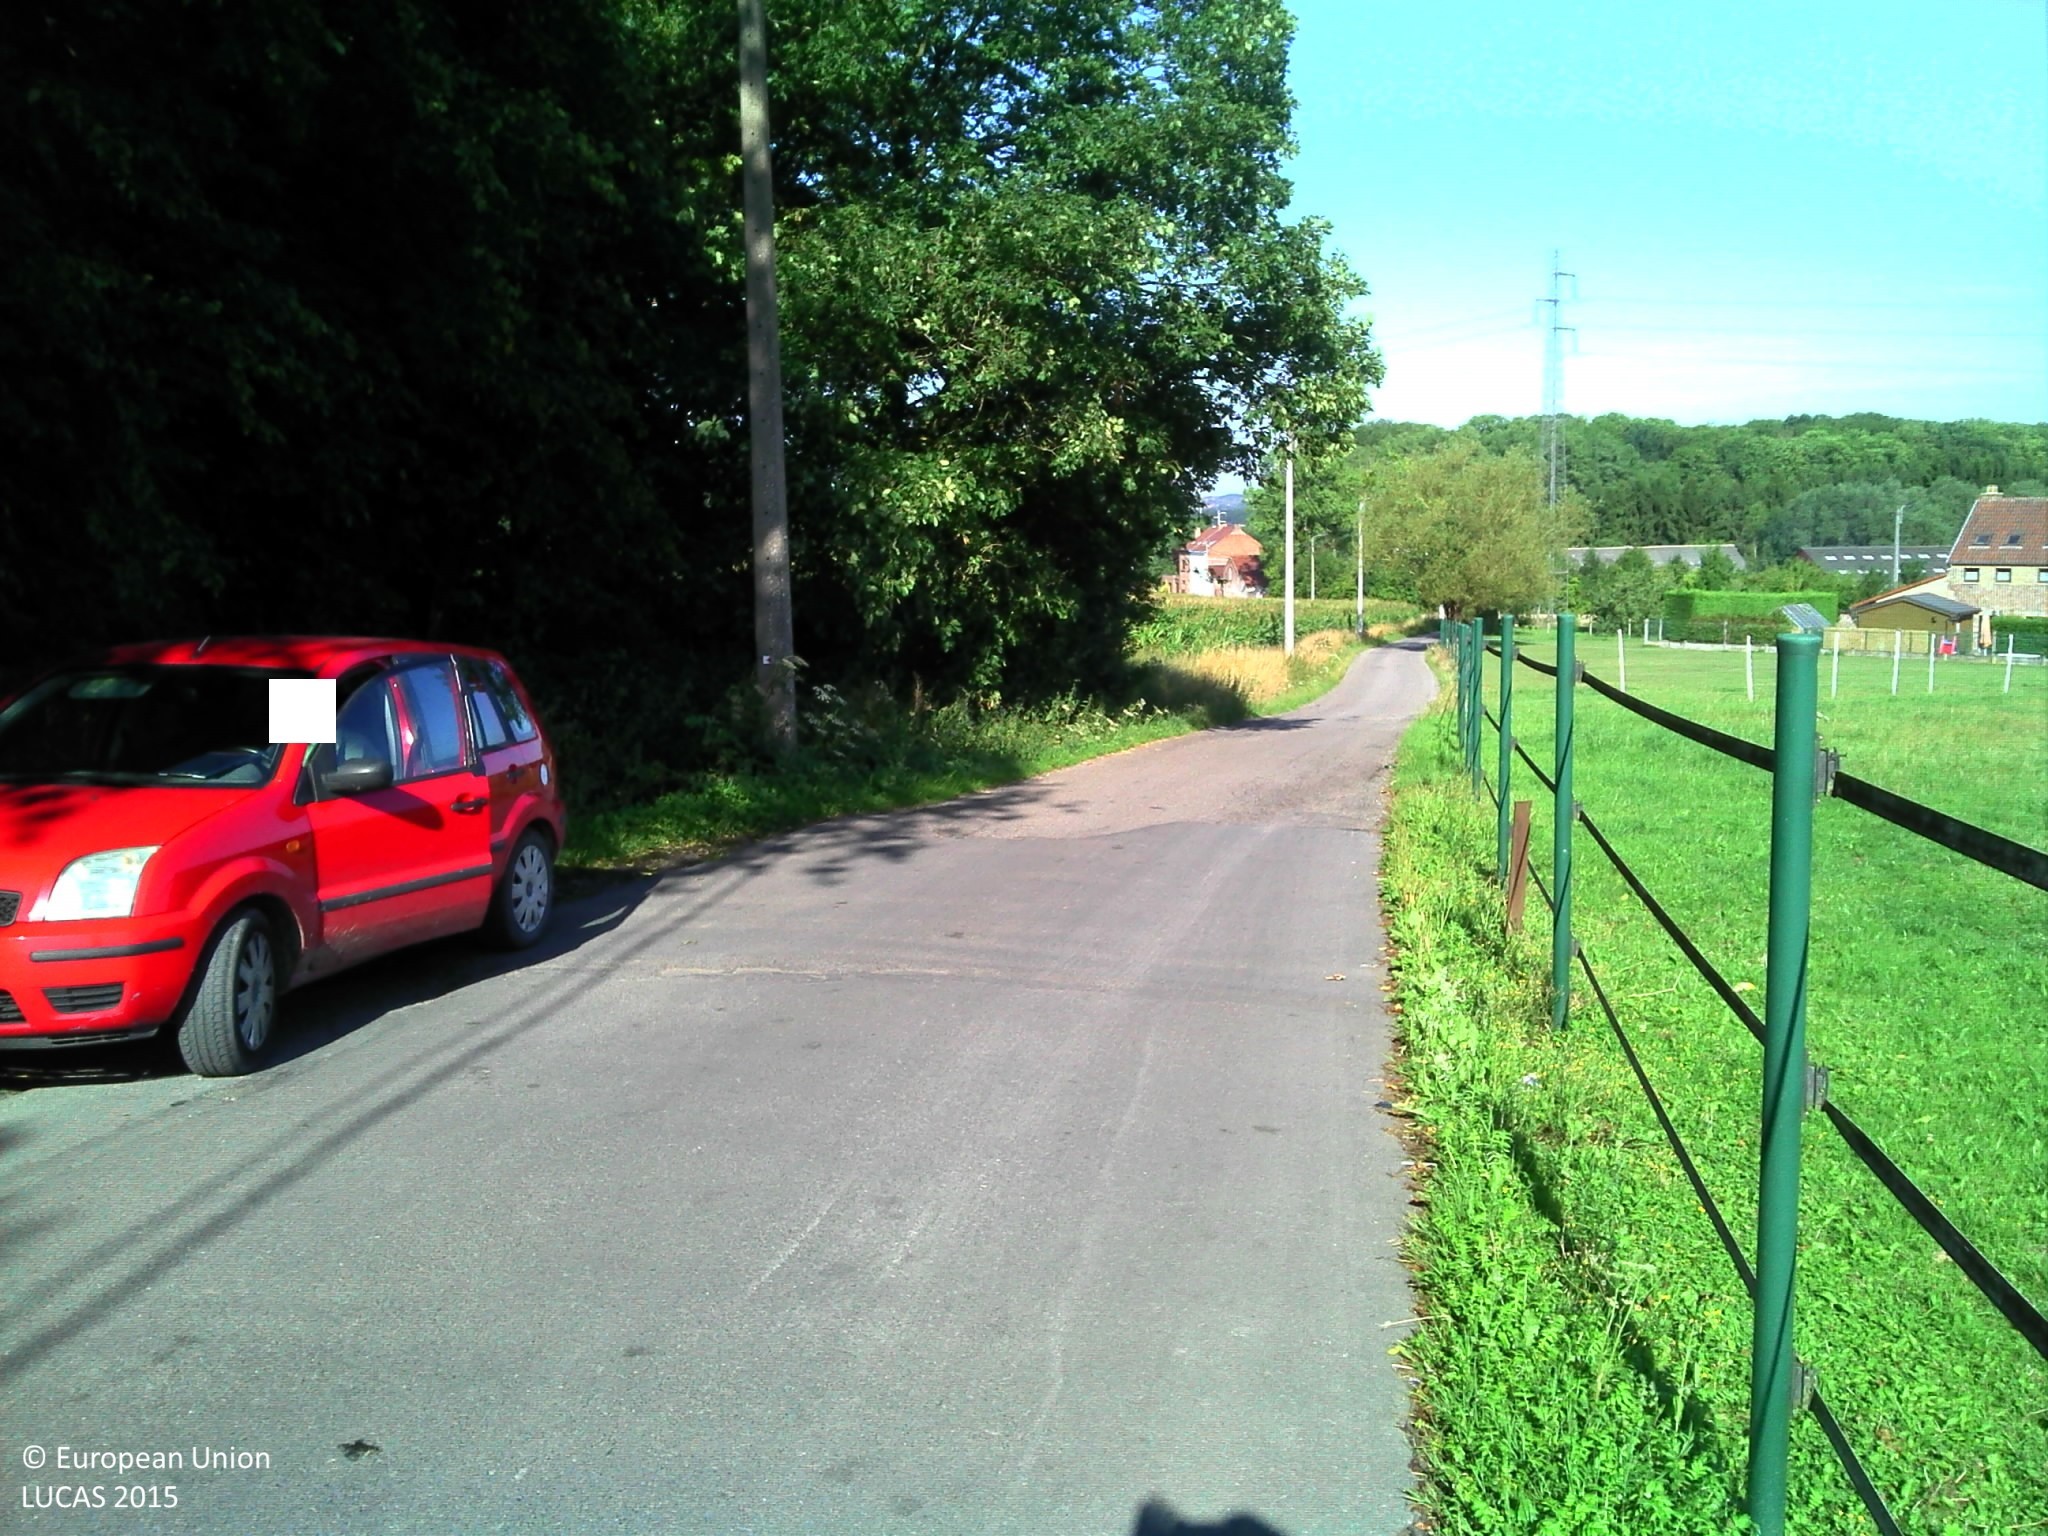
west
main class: Grassland
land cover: Grassland without tree/shrub cover
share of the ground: > 75 %
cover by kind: herbaceous plants 100 %
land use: Agriculture (excluding fallow land and kitchen gardens)
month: August
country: BE
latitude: 50.4171
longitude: 4.6060
